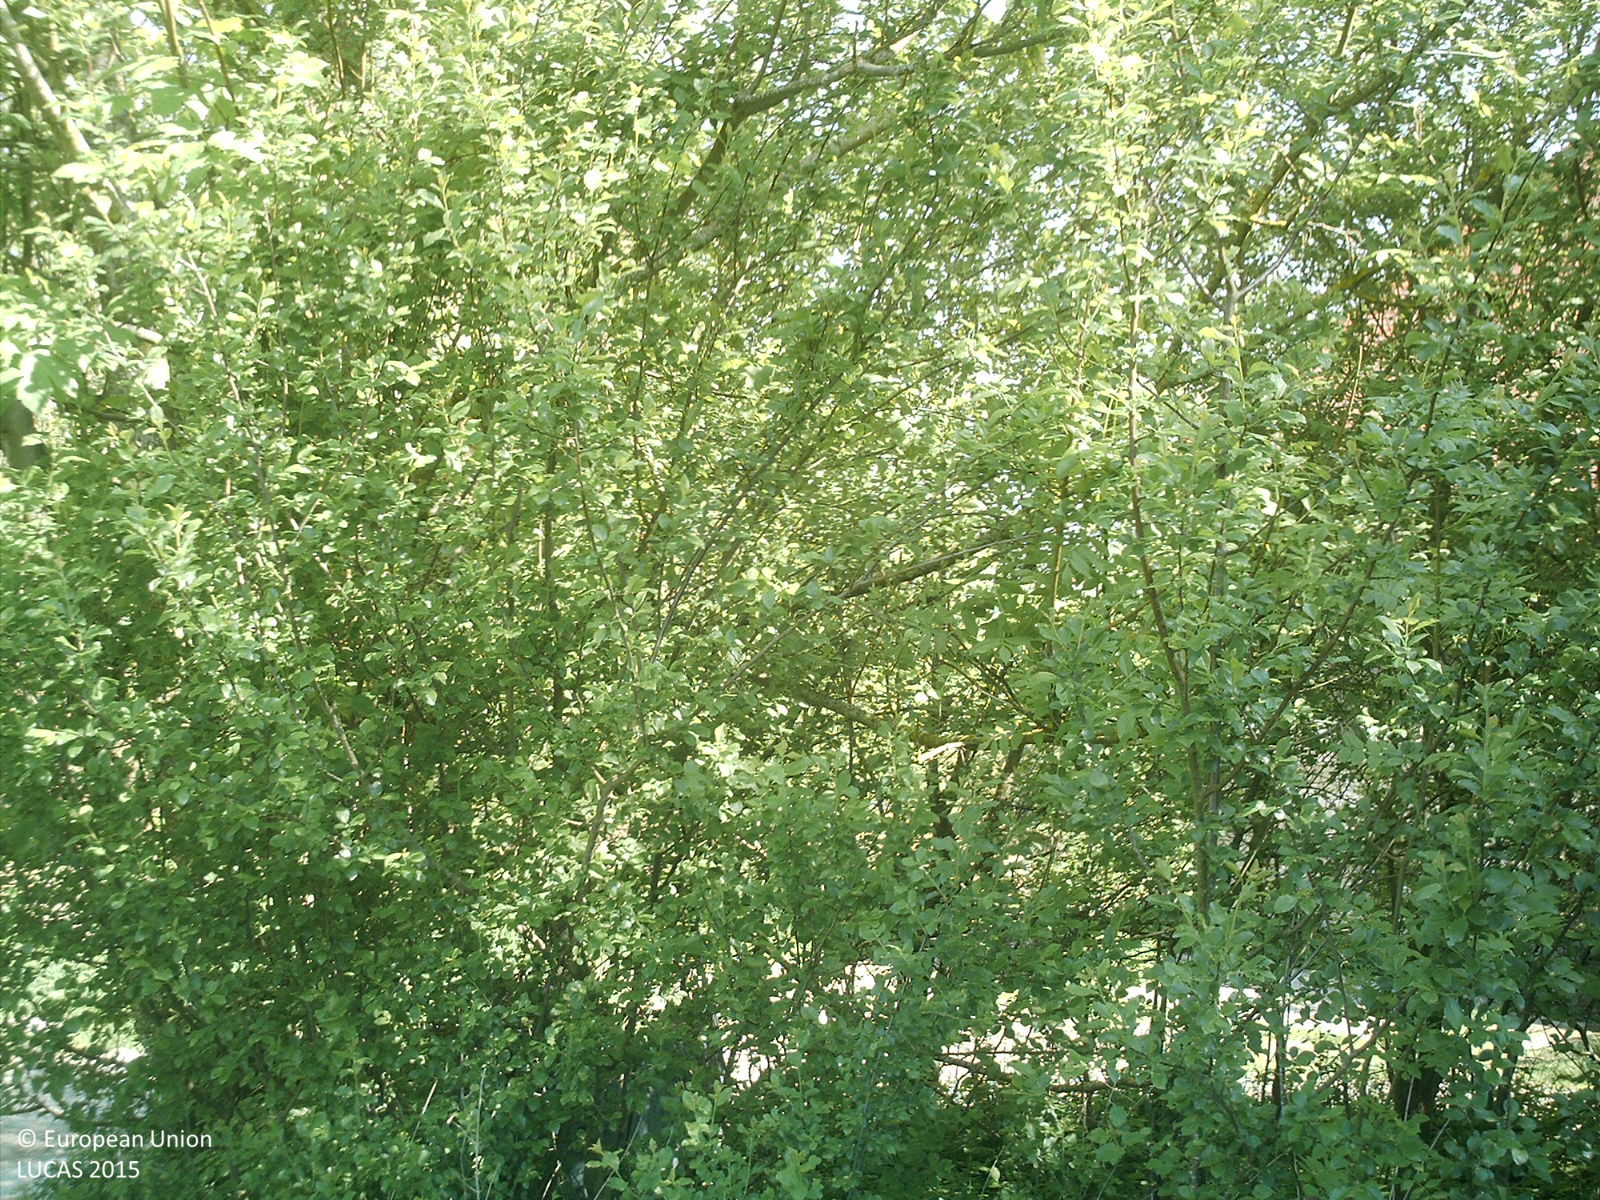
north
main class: Woodland
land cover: Broadleaved woodland
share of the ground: 50 - 75 %
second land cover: Grassland without tree/shrub cover
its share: > 75 %
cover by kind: broadleaved forest trees 50 %, shrubs 50 %
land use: Residential
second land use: Agriculture (excluding fallow land and kitchen gardens)
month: May
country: AT
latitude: 47.9138
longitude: 14.0804
